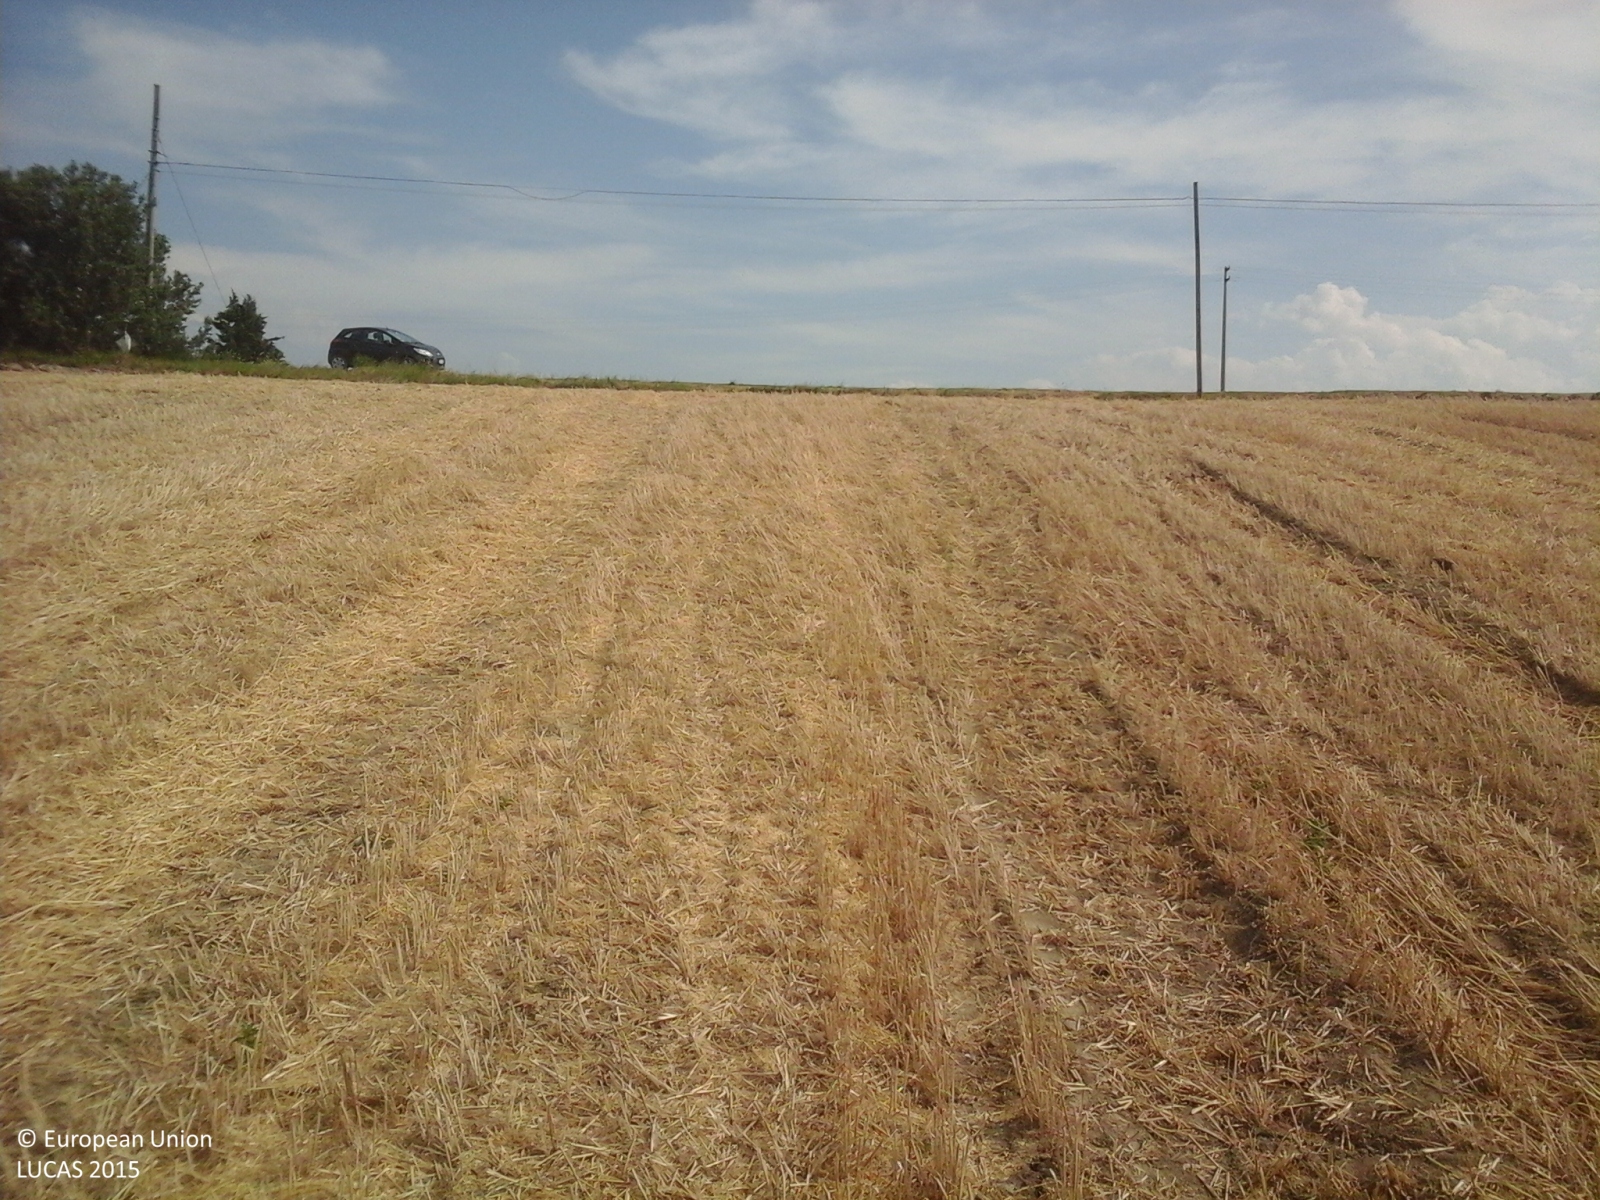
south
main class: Cropland
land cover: Durum wheat
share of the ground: > 75 %
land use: Agriculture (excluding fallow land and kitchen gardens)
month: July
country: IT
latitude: 43.2122
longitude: 13.3761
